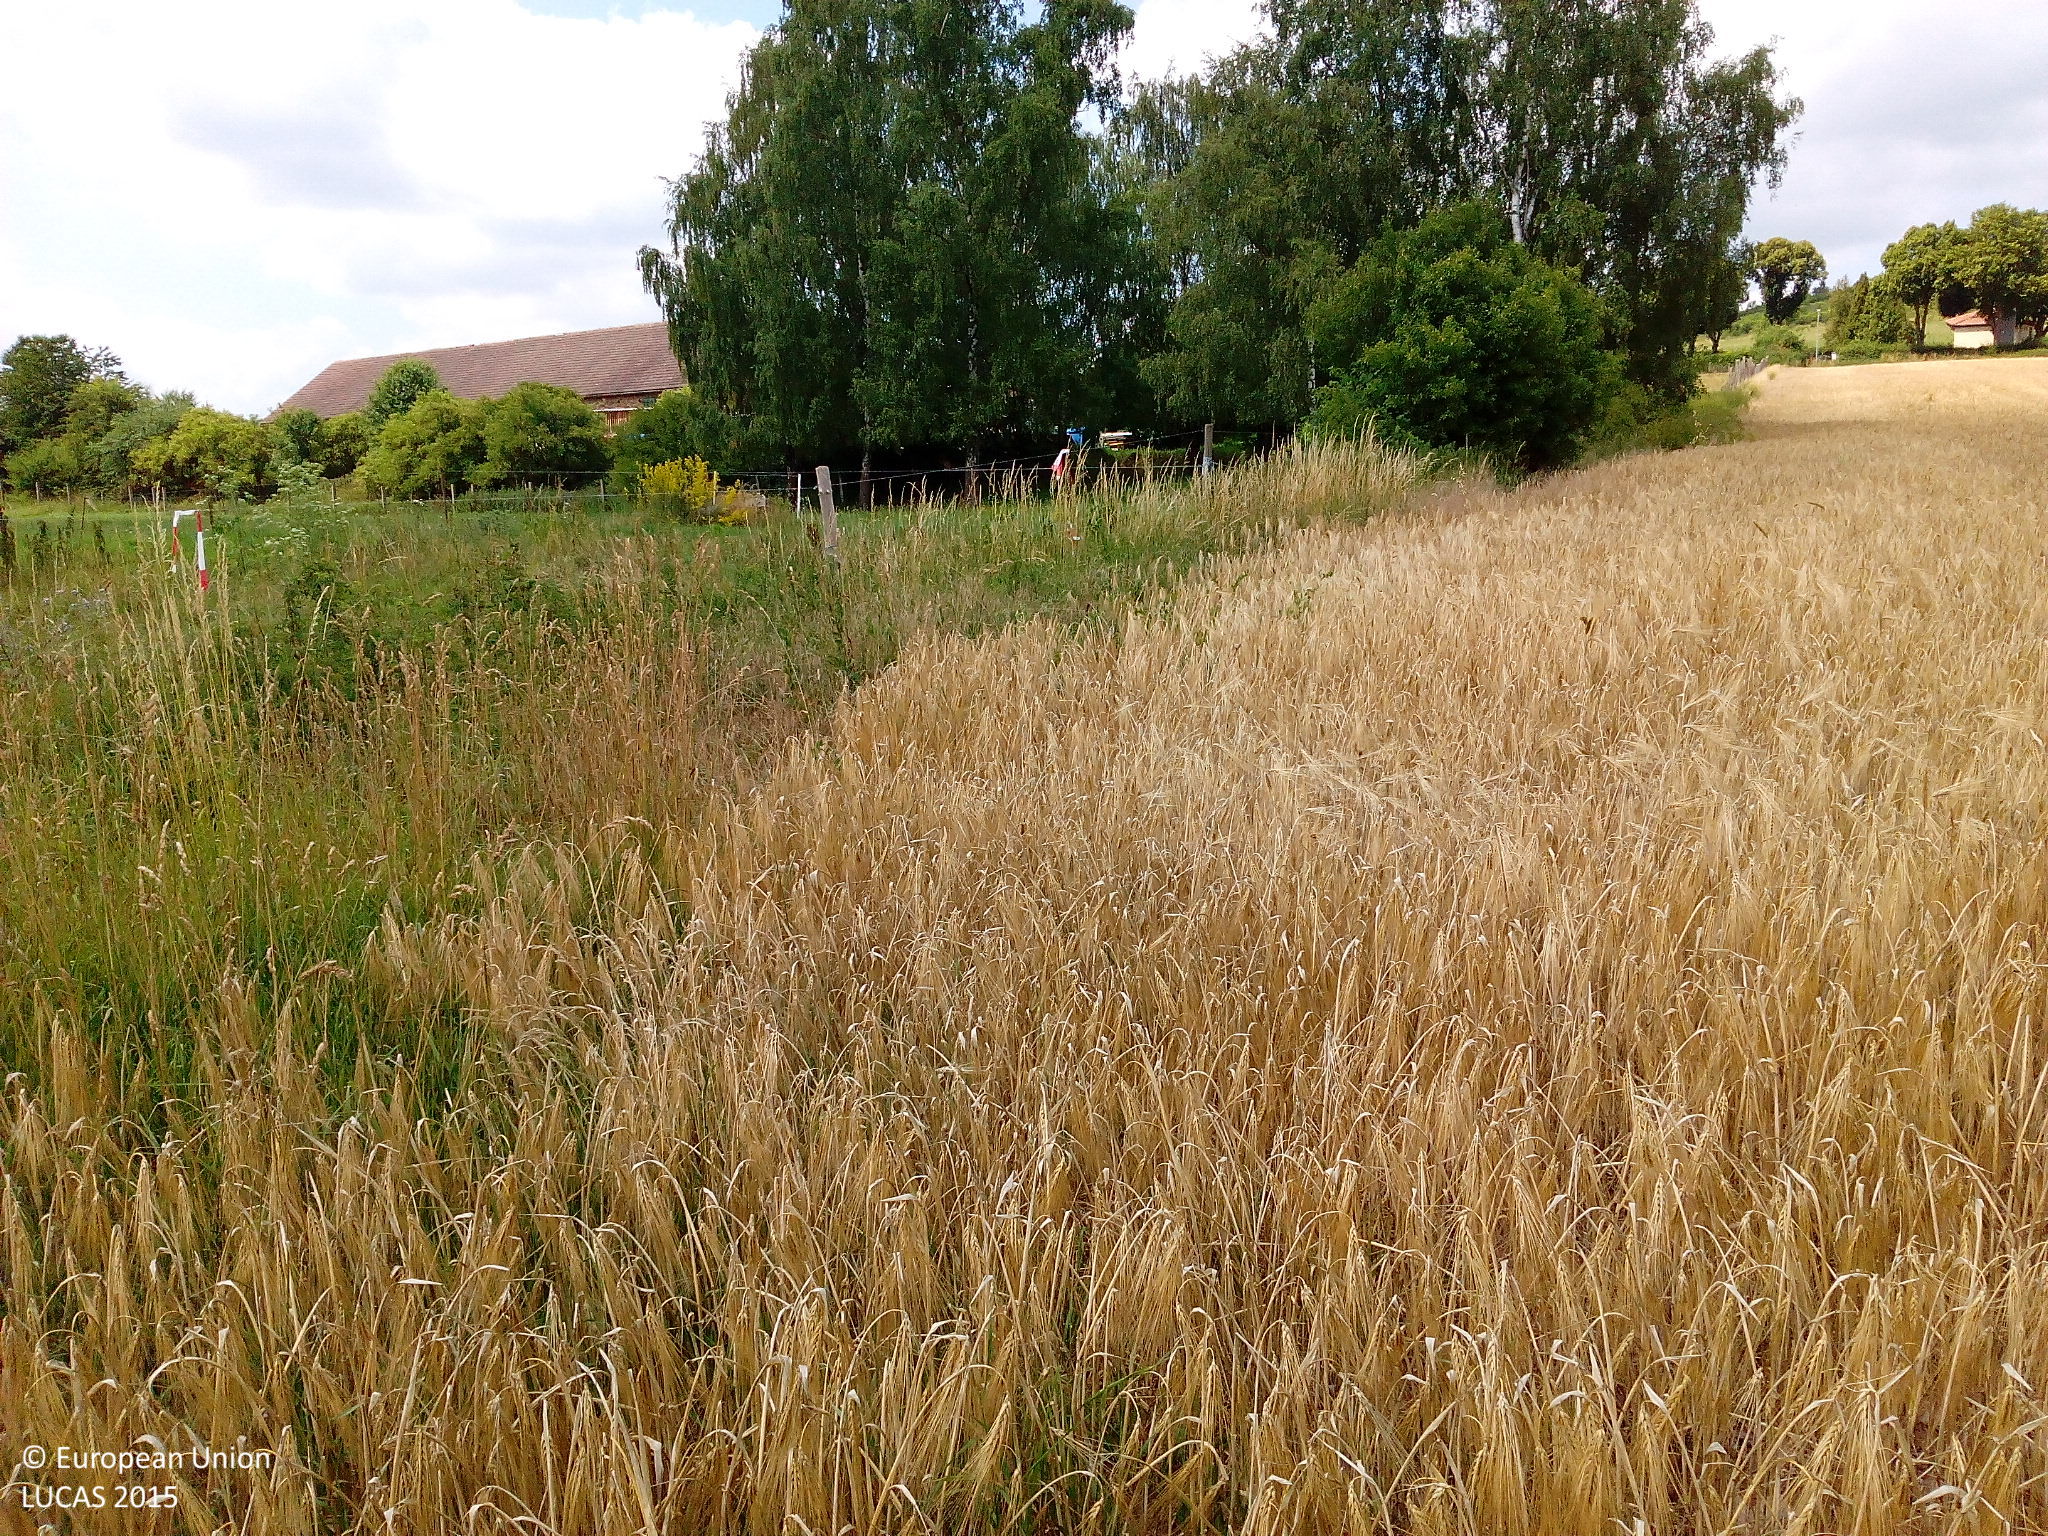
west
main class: Cropland
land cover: Barley
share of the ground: > 75 %
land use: Agriculture (excluding fallow land and kitchen gardens)
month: July
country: DE
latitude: 50.7056
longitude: 9.9292
